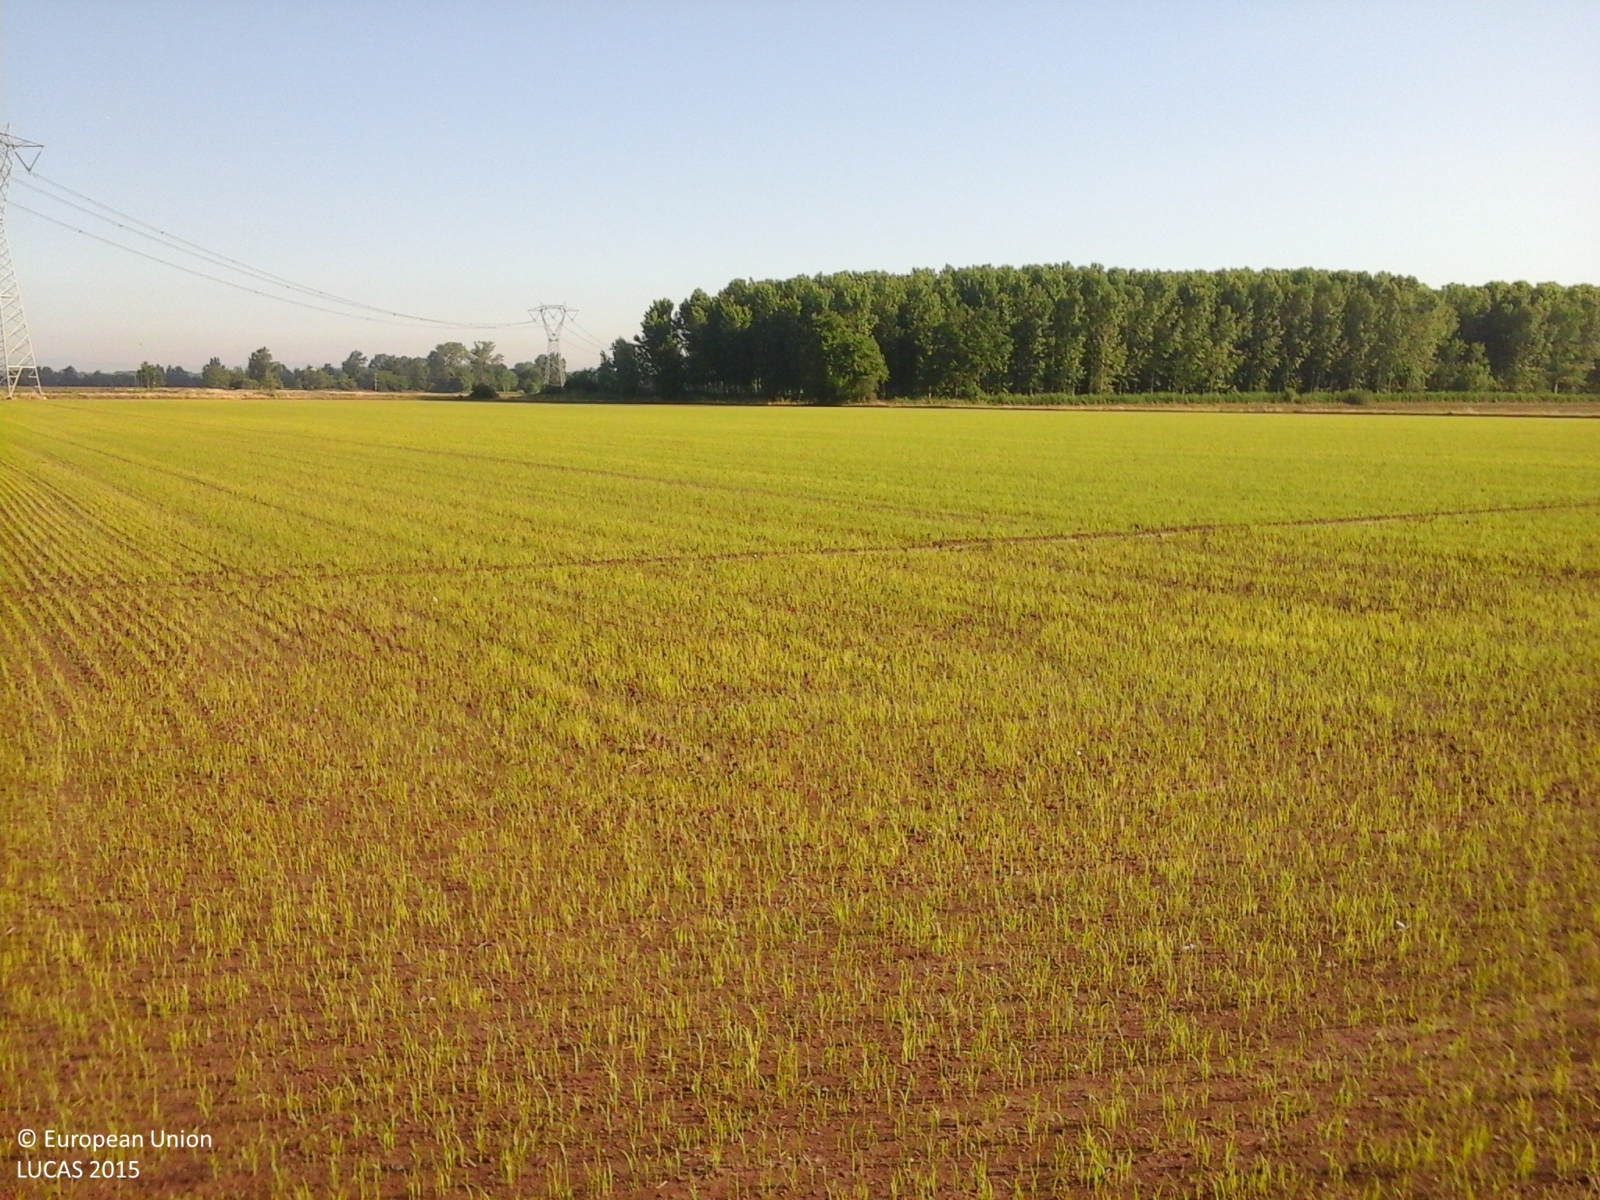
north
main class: Cropland
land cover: Rice
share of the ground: 10 - 25 %
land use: Agriculture (excluding fallow land and kitchen gardens)
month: May
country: IT
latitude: 45.3744
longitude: 9.0950
